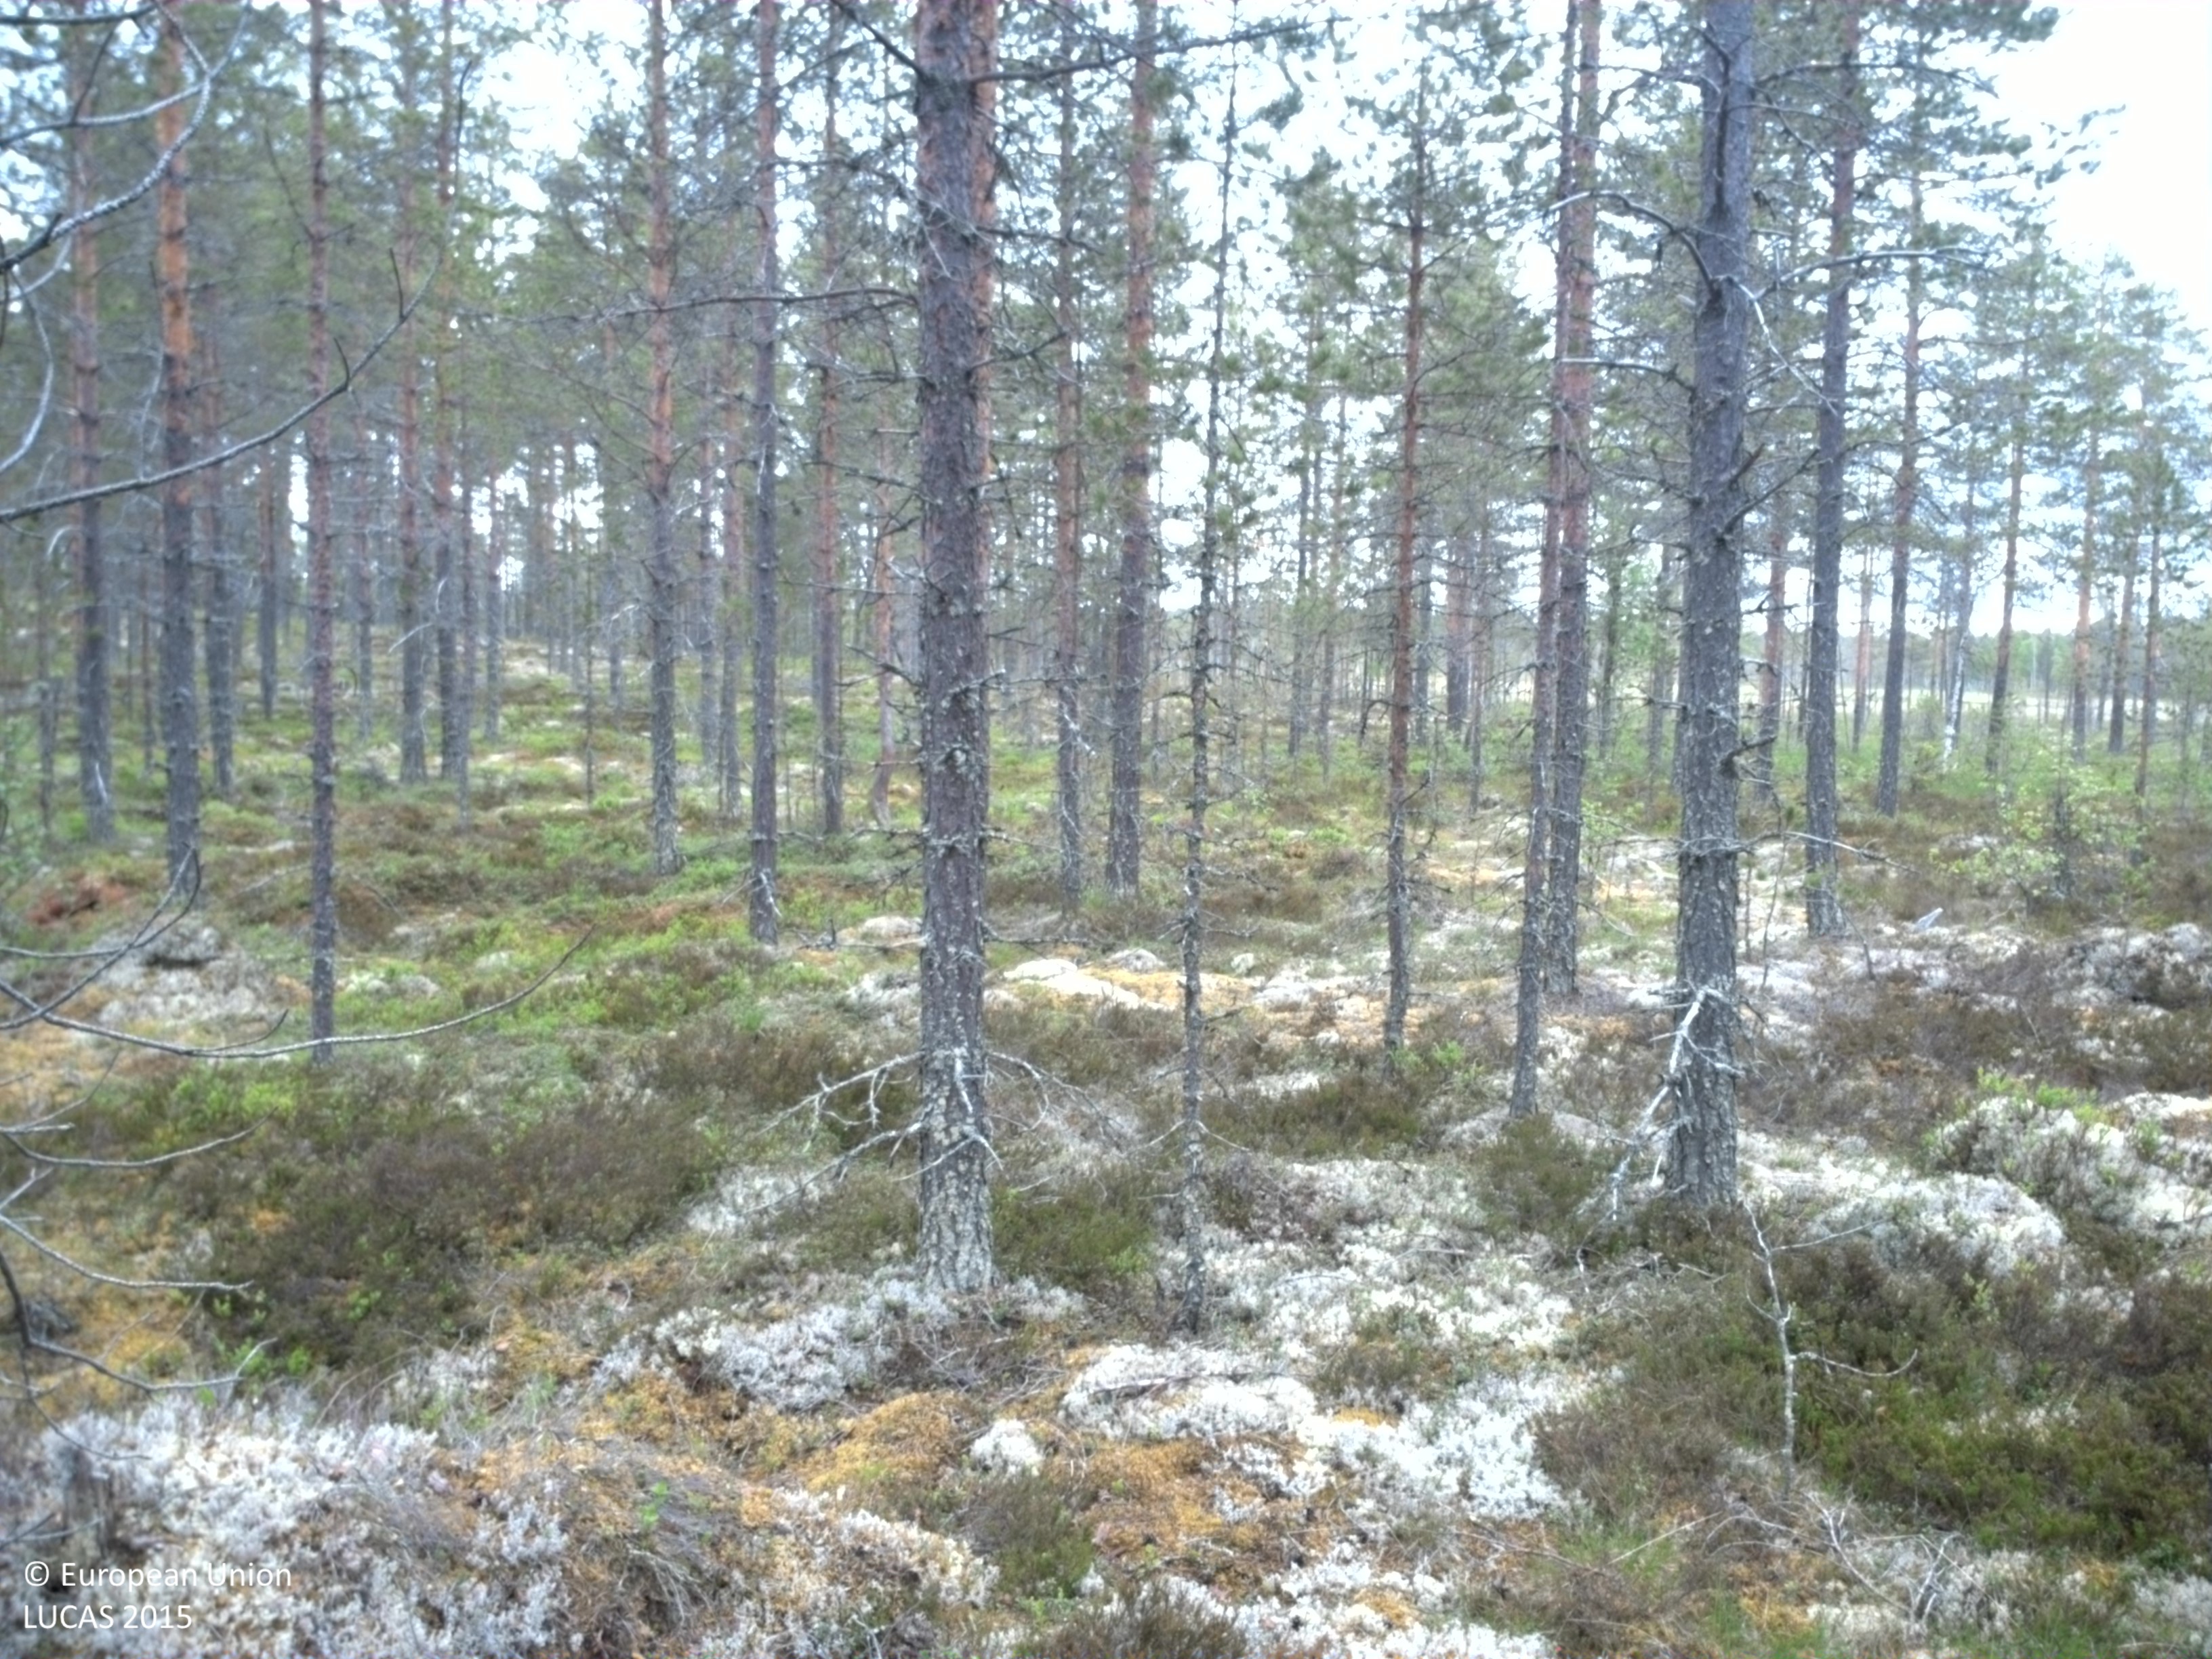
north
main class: Woodland
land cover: Pine dominated coniferous woodland
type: boreal forest
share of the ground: 50 - 75 %
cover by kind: coniferous forest trees 60 %, herbaceous plants 15 %, lichens and mosses 15 %, broadleaved forest trees 10 %
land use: Forestry
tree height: > 5 m
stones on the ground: < 10 %
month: June
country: SE
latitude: 61.1979
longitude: 13.6161
